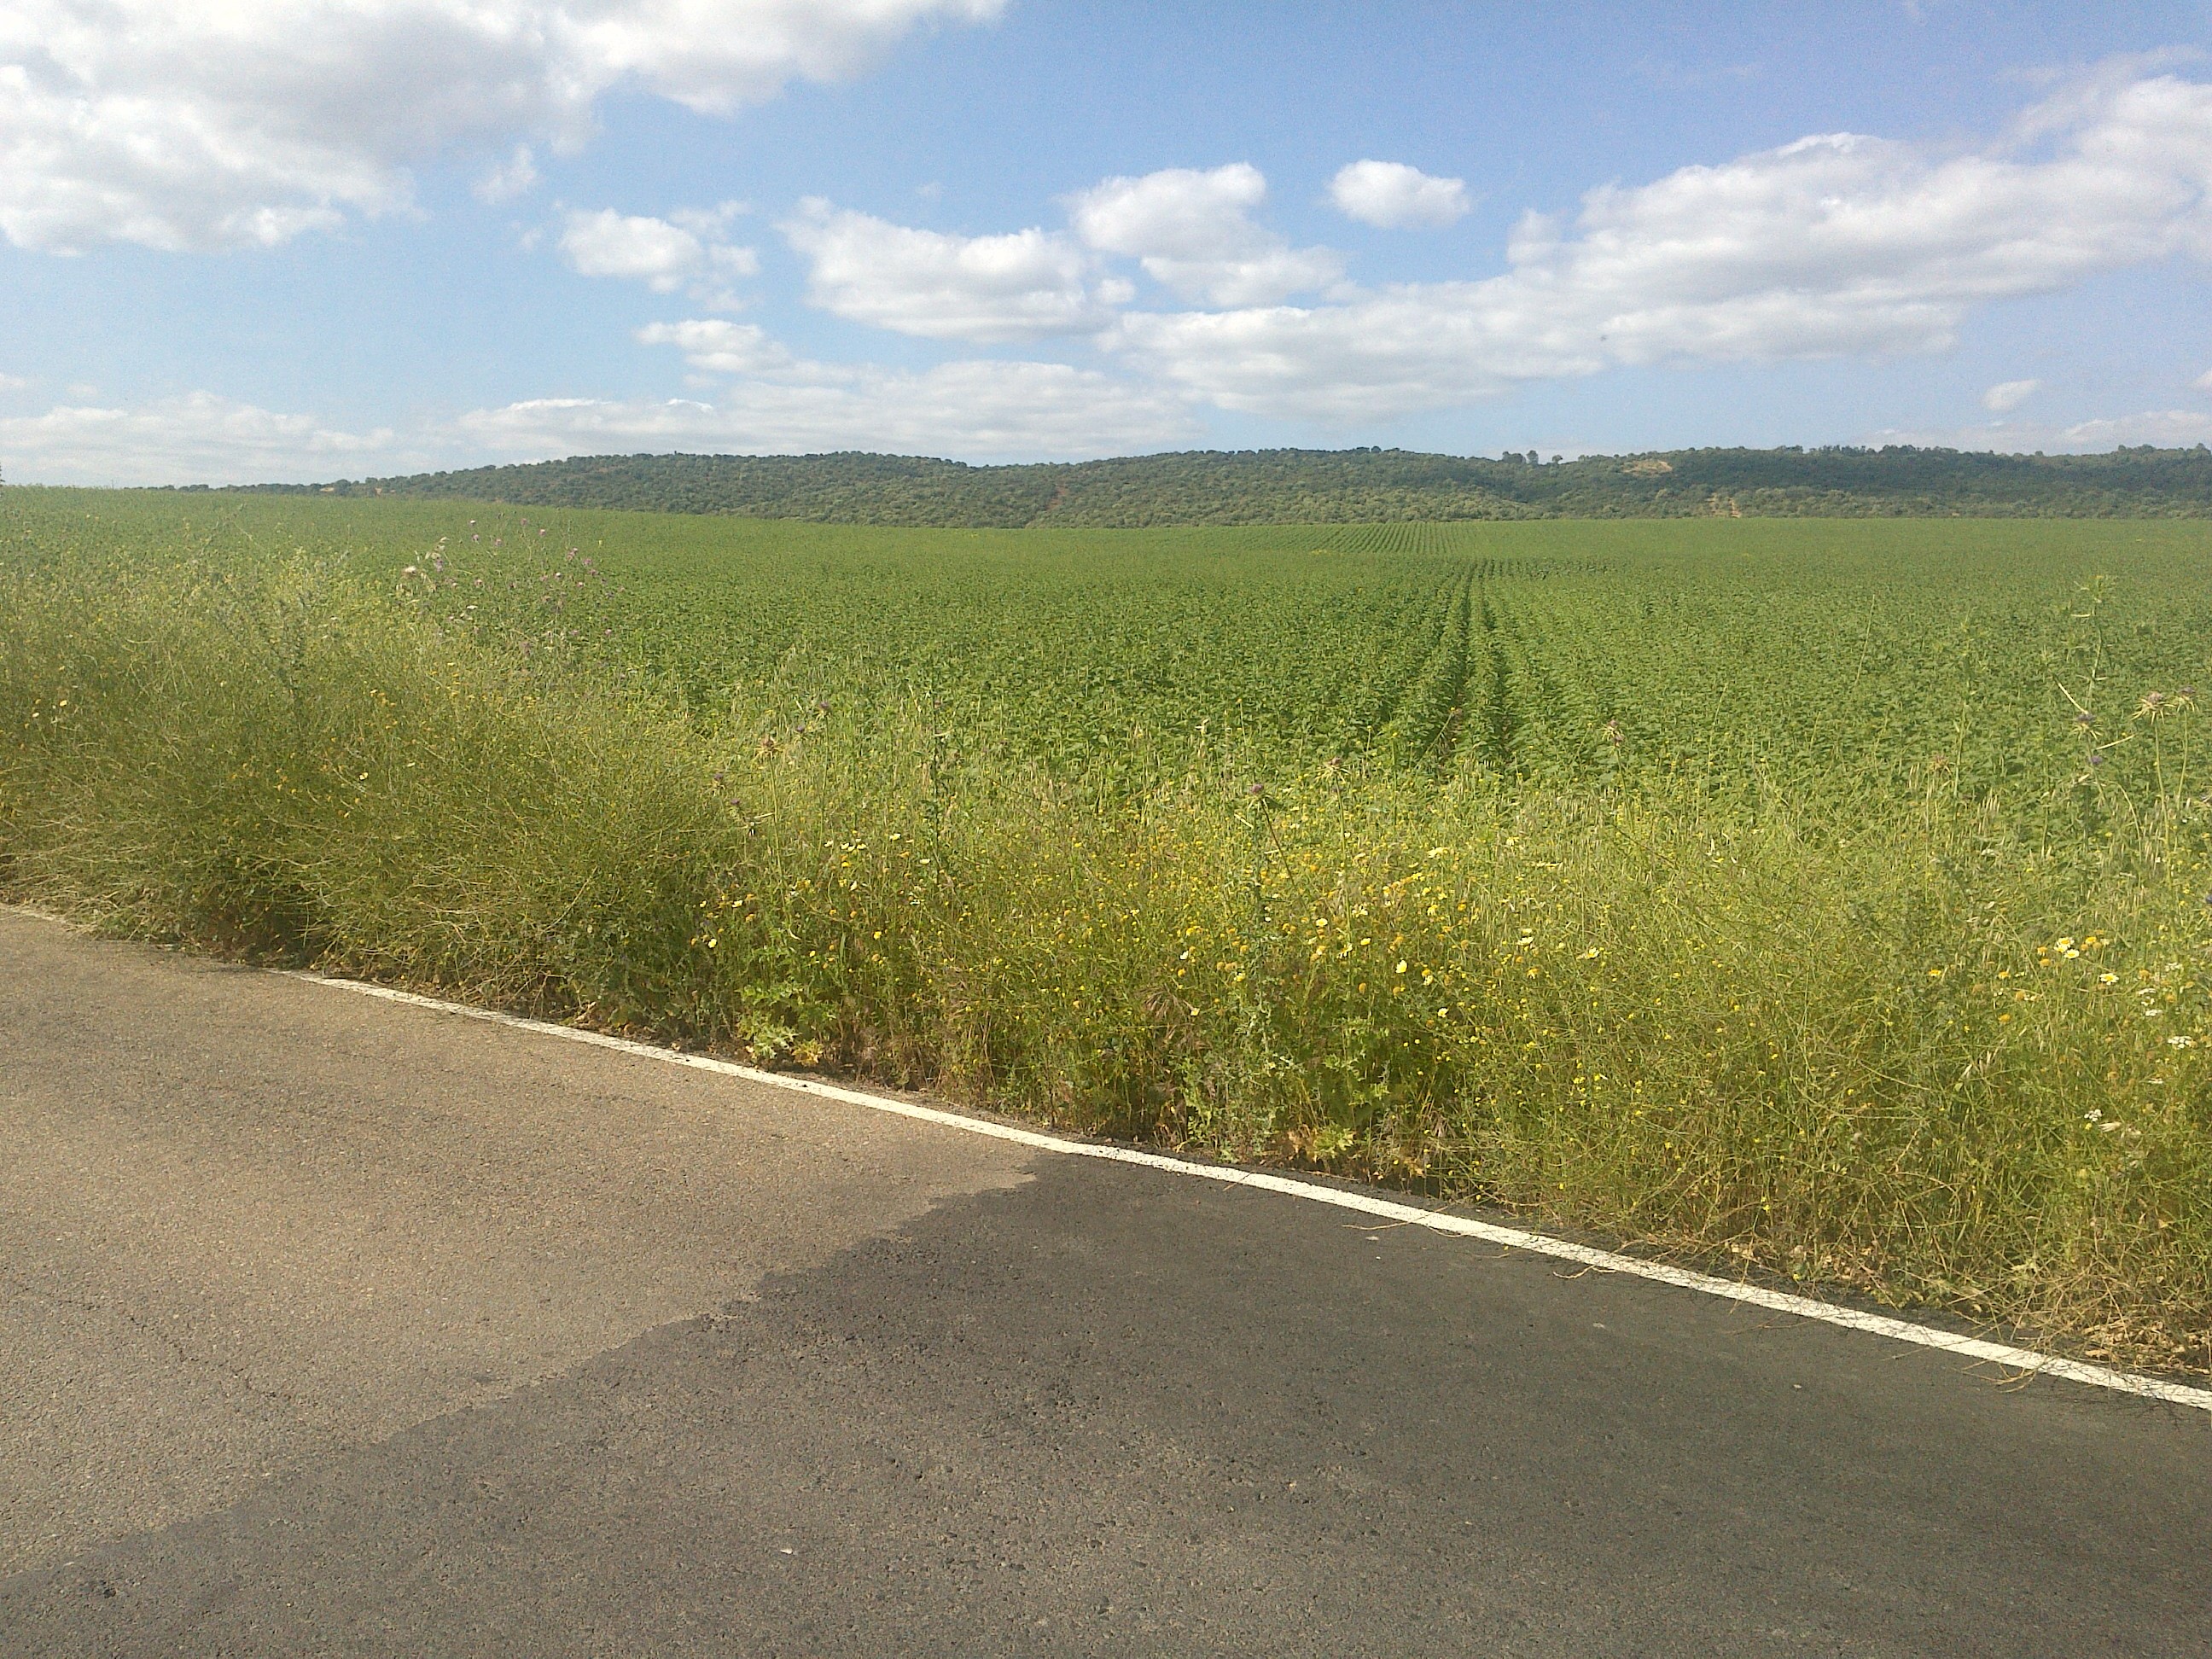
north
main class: Cropland
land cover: Sunflower
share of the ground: > 75 %
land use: Agriculture (excluding fallow land and kitchen gardens)
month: May
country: ES
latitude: 37.8093
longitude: -5.1825
